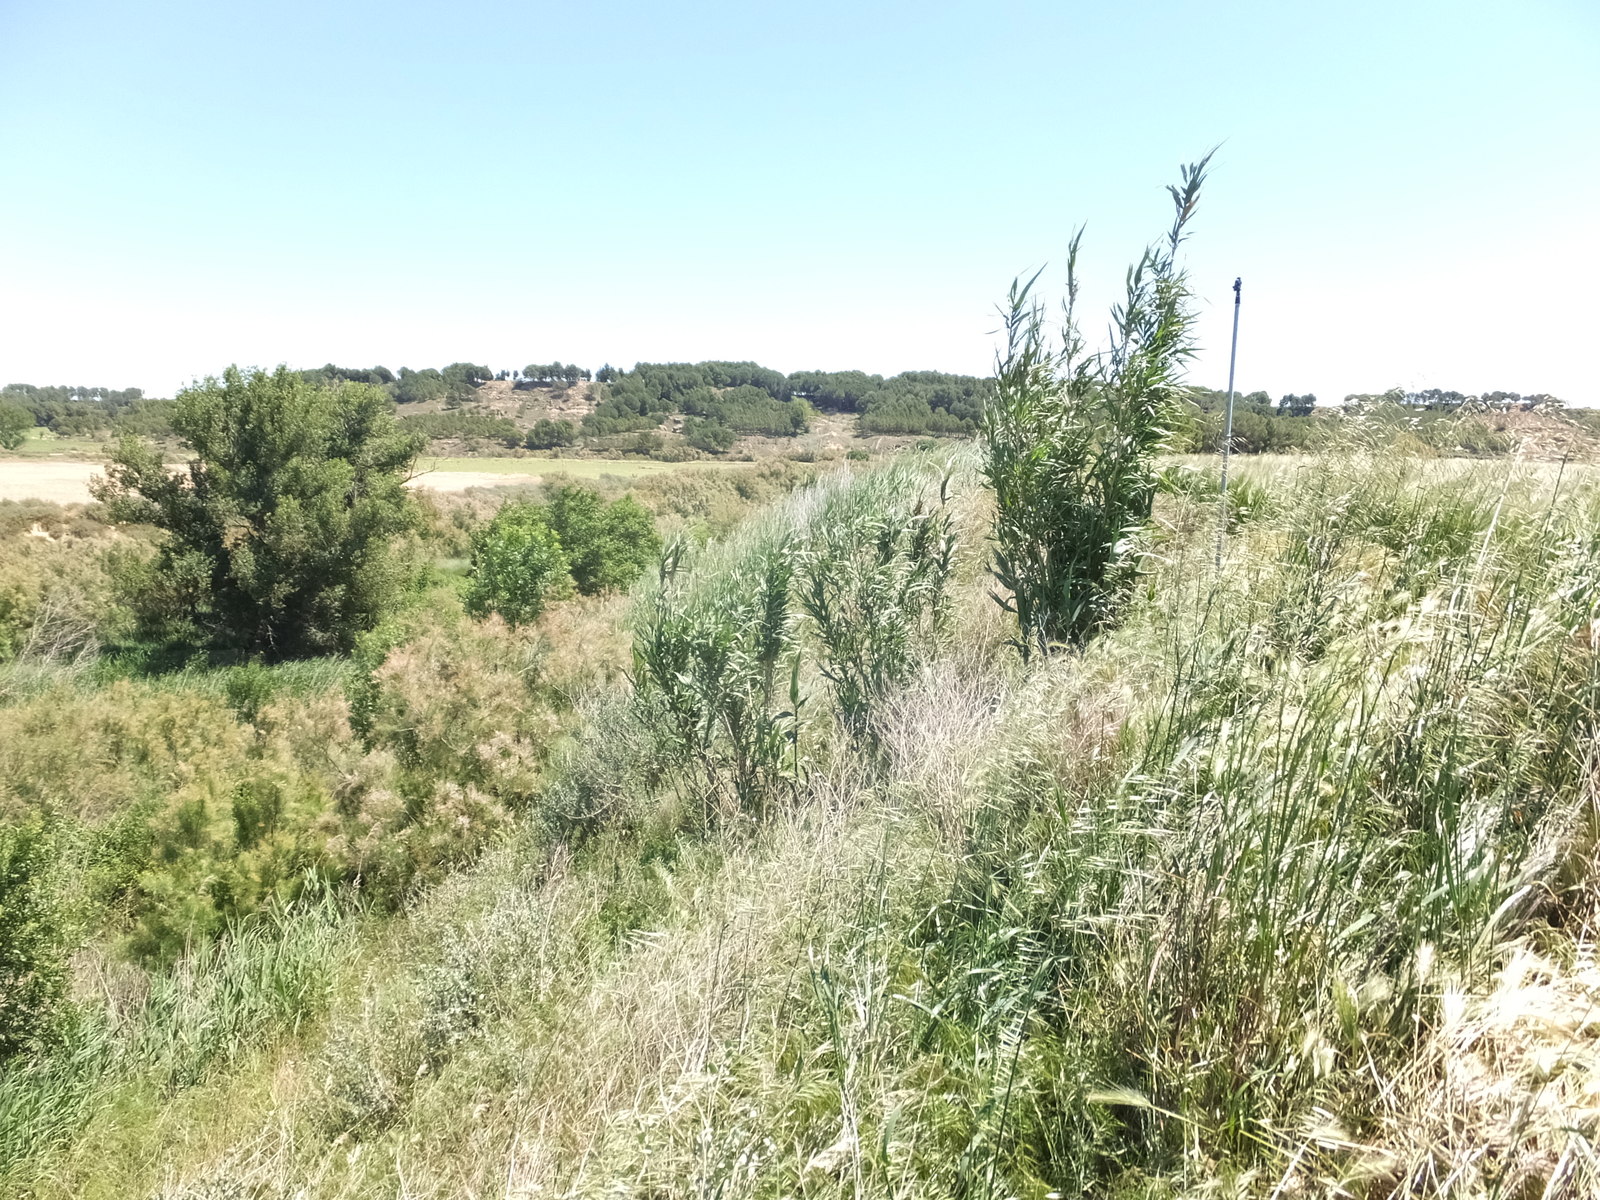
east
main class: Grassland
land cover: Spontaneously vegetated surfaces
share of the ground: > 75 %
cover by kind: herbaceous plants 80 %, consolidated bare surface 15 %, shrubs 5 %
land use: Semi-natural and natural areas not in use
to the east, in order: Spontaneously vegetated surfaces; Rocks and stones; Shruby margins; Rock outcrops; Shrubland without tree cover; Barley; Pine dominated coniferous woodland; Barley
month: May
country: ES
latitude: 41.8089
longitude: -0.2137
